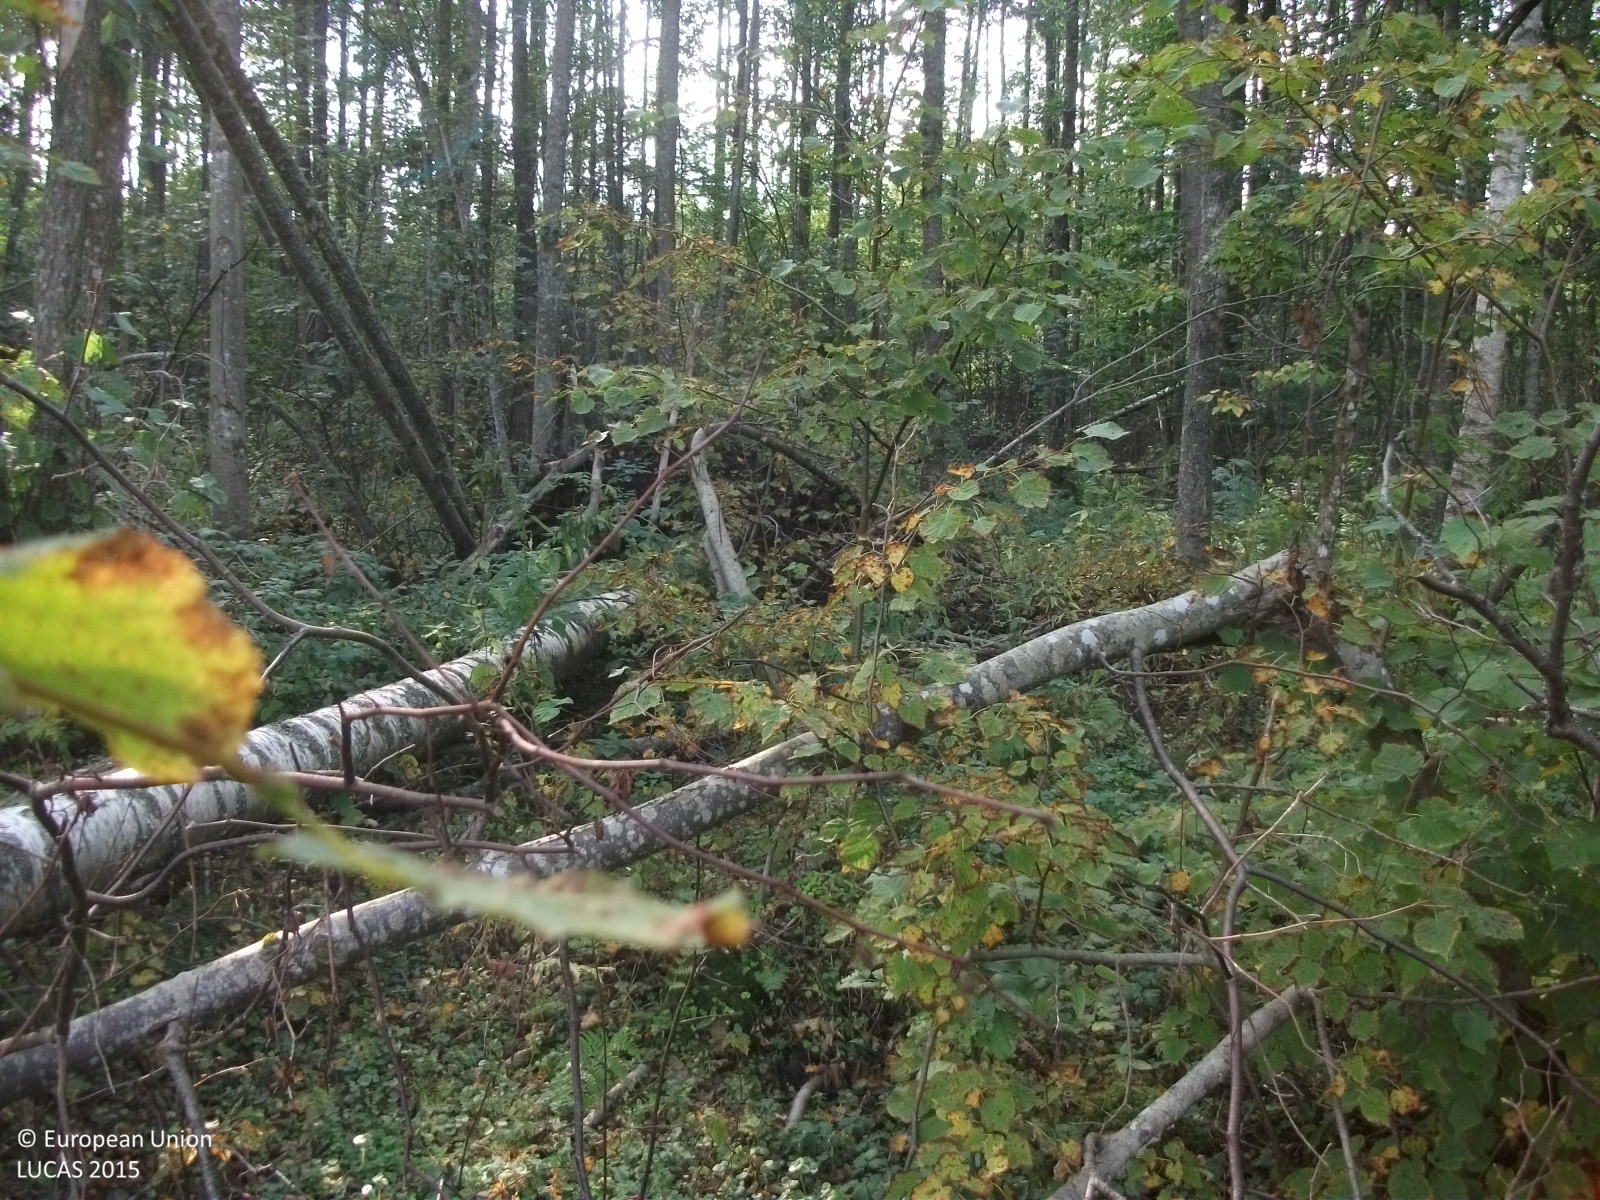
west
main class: Woodland
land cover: Broadleaved woodland
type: non-riverine alder, birch or aspen forest
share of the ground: > 75 %
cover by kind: broadleaved forest trees 80 %, herbaceous plants 10 %, shrubs 5 %
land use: Forestry
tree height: > 5 m
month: September
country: LV
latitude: 57.8383
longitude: 24.5934
